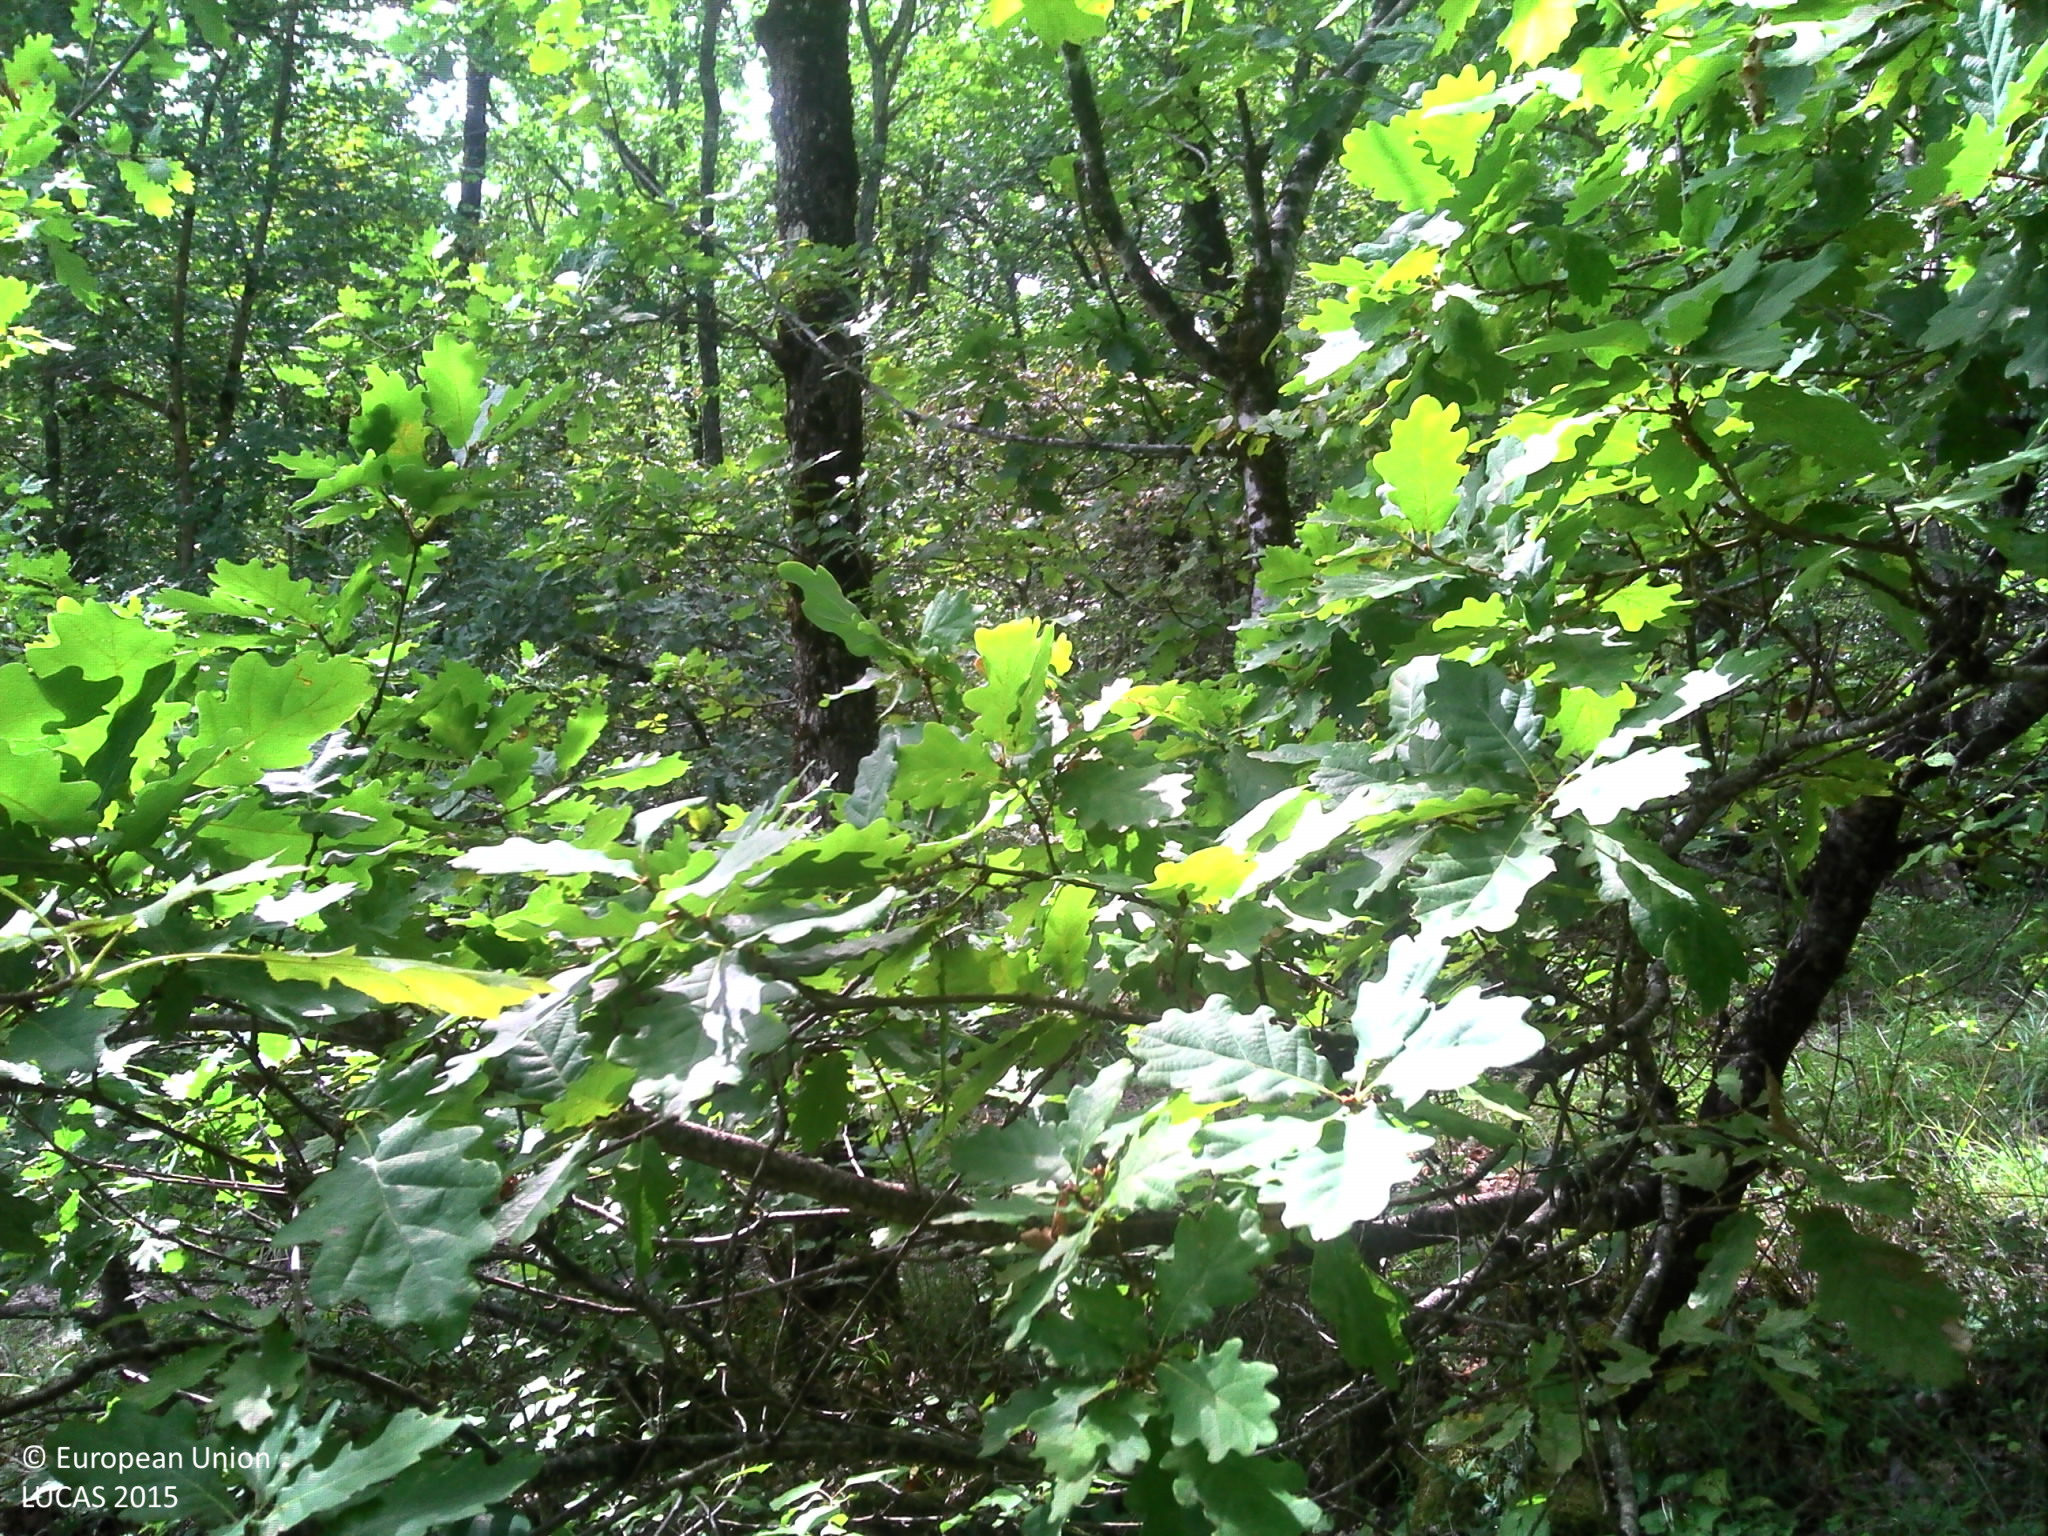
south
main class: Woodland
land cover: Broadleaved woodland
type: thermophilous deciduous forest
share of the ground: > 75 %
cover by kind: broadleaved forest trees 80 %, shrubs 10 %, herbaceous plants 10 %
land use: Forestry
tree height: > 5 m
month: August
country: FR
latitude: 44.3571
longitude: 1.2023
